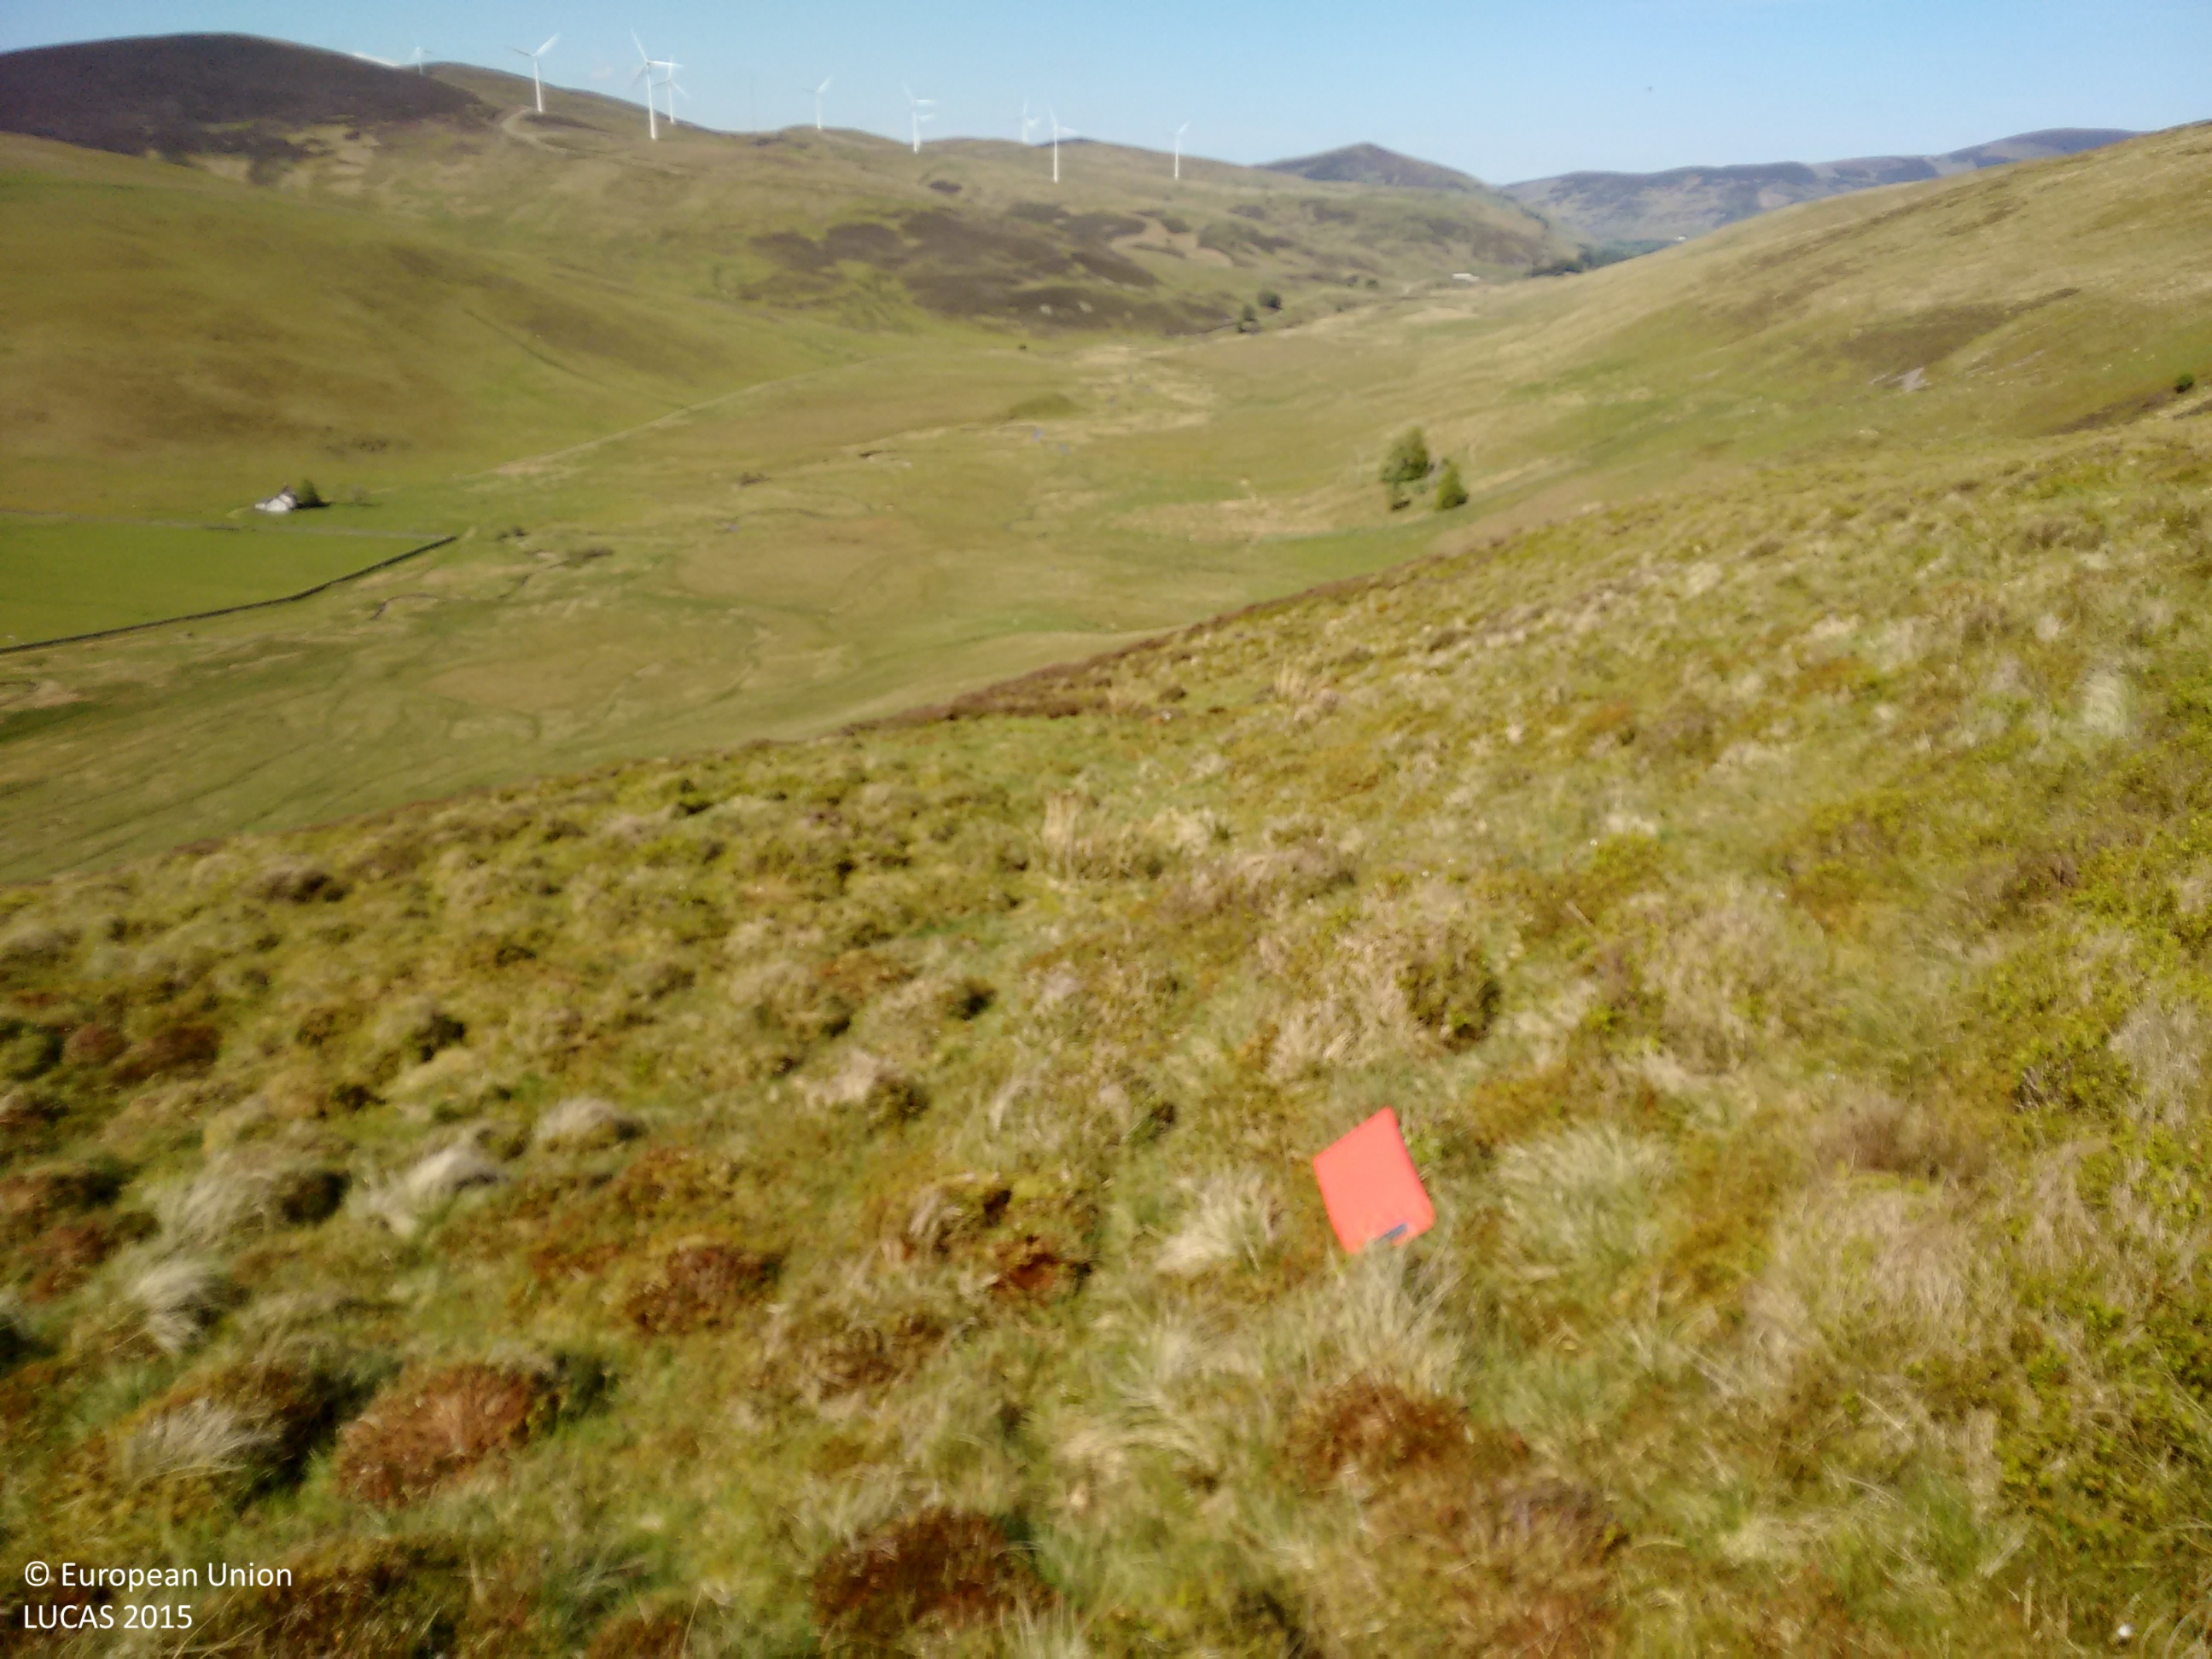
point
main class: Shrubland
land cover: Shrubland without tree cover
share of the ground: 25 - 50 %
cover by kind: shrubs 45 %, herbaceous plants 45 %, lichens and mosses 10 %
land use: Semi-natural and natural areas not in use
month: June
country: GB
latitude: 55.5109
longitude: -3.4588
